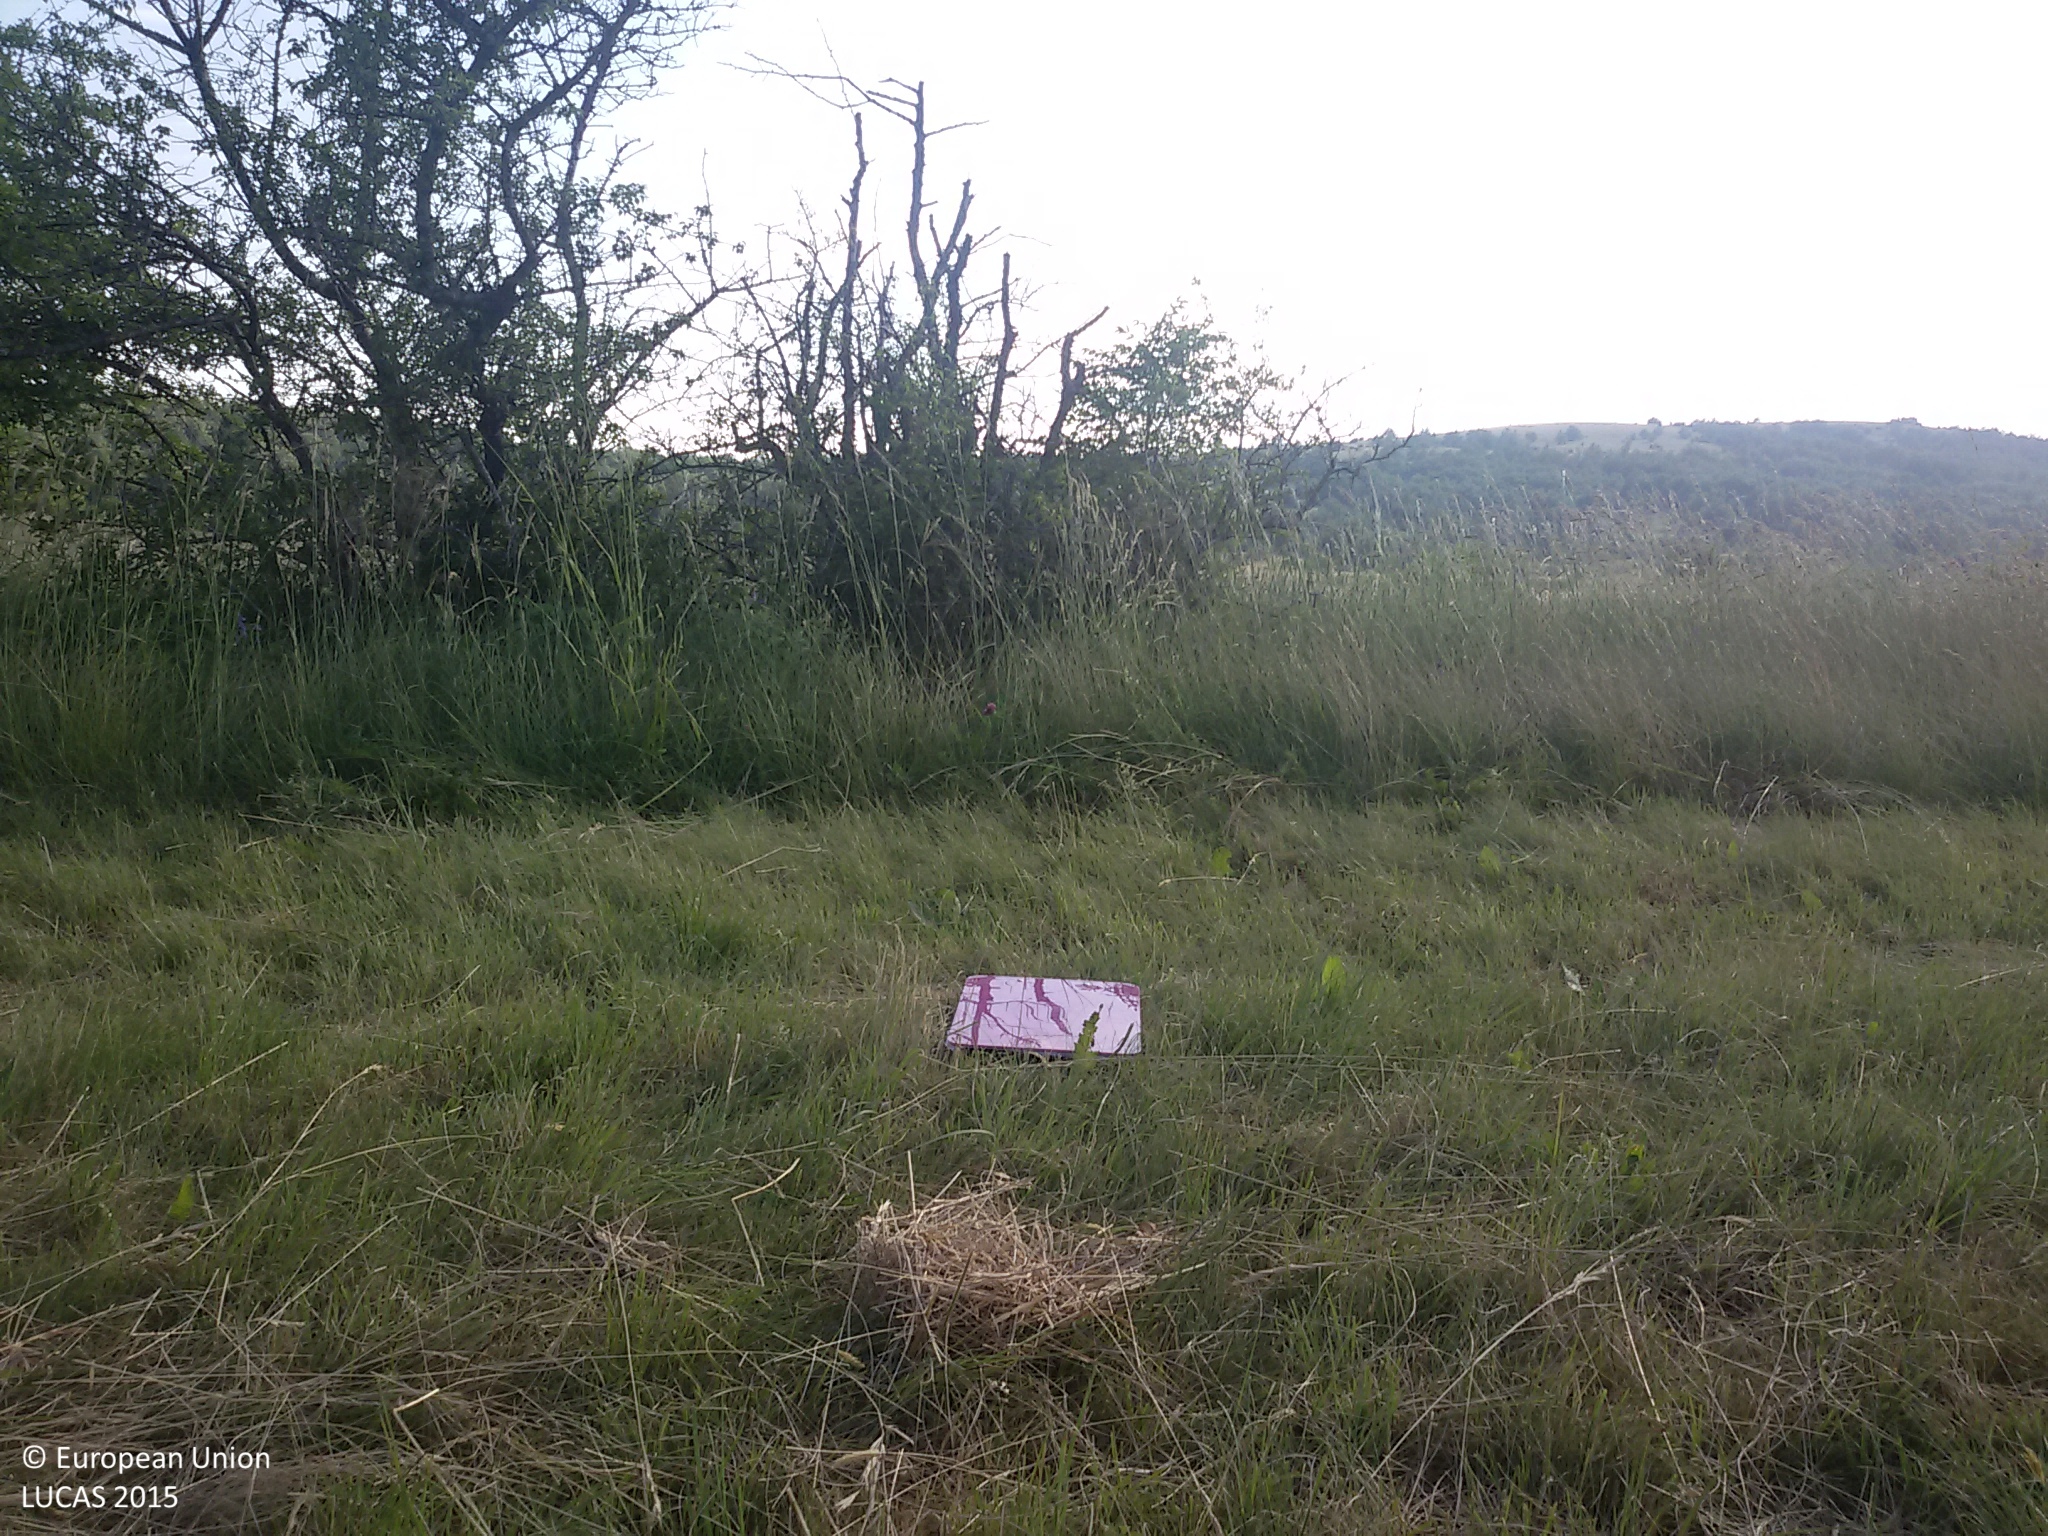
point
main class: Grassland
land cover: Grassland without tree/shrub cover
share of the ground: > 75 %
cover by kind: herbaceous plants 95 %, unconsolidated bare surface 5 %
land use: Agriculture (excluding fallow land and kitchen gardens)
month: June
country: HR
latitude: 44.5169
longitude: 15.7429
